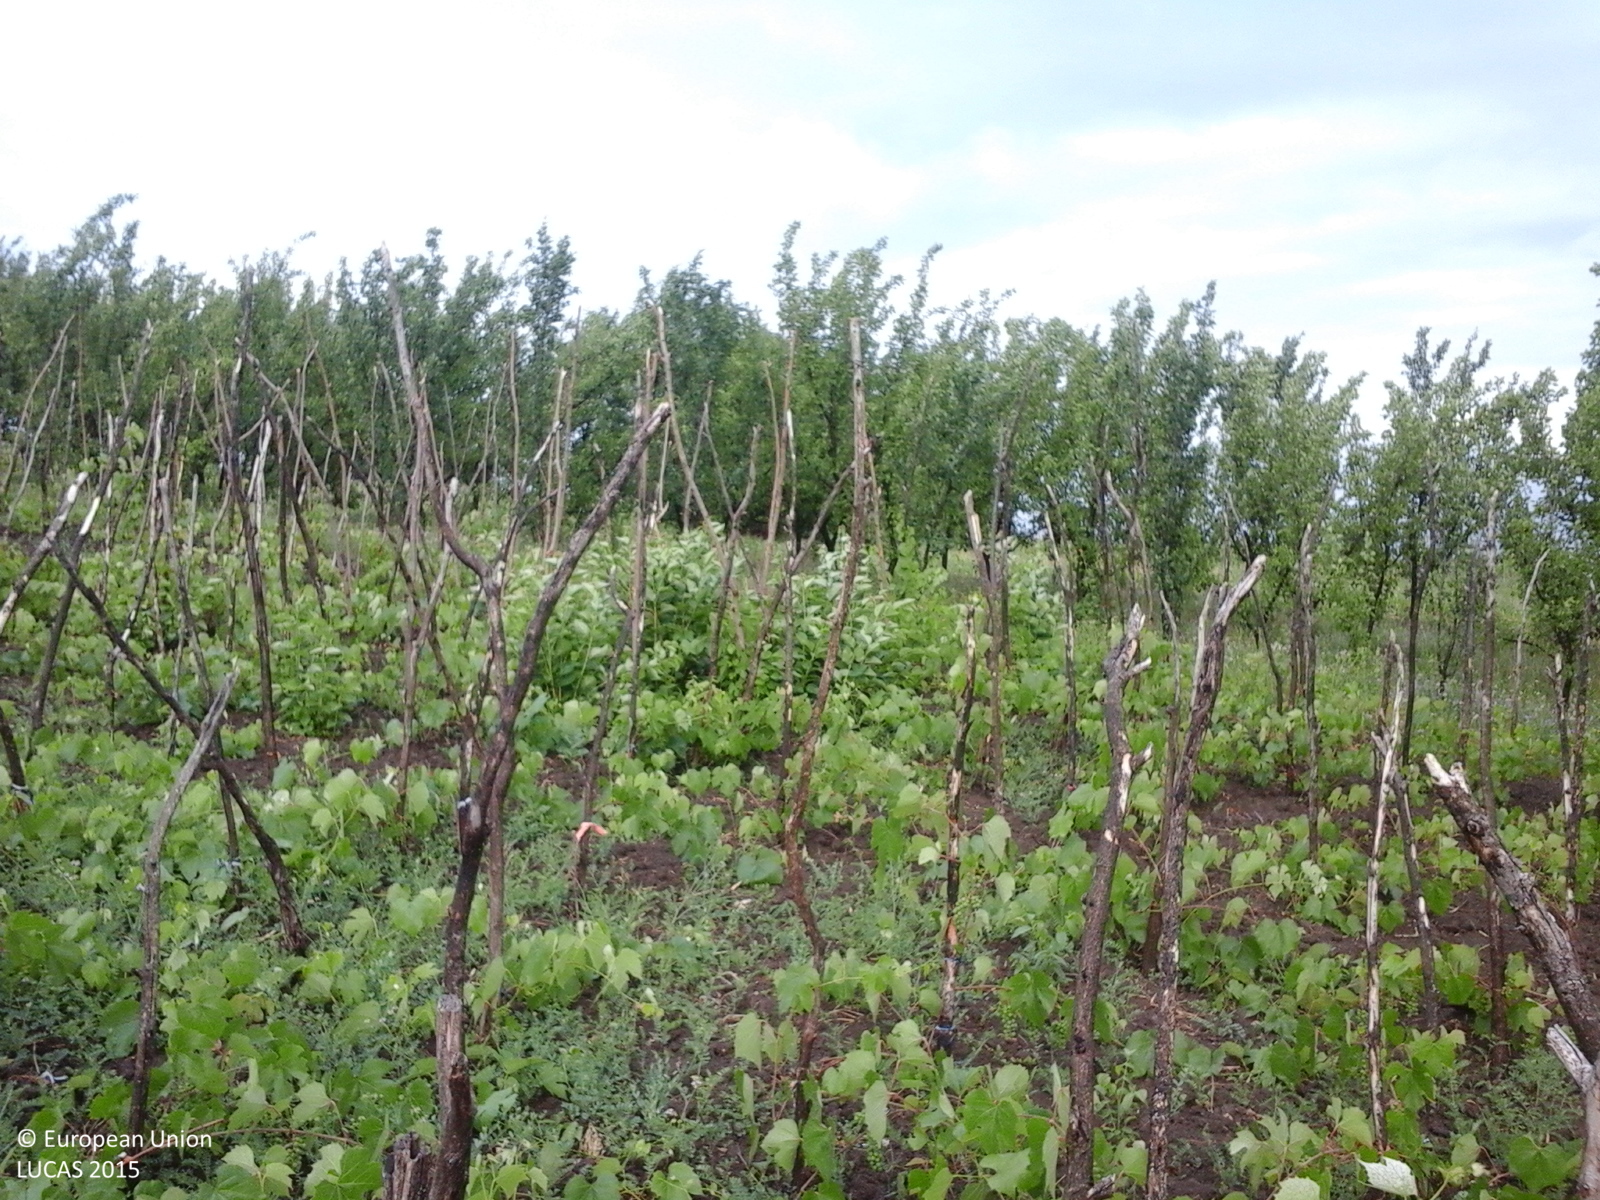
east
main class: Cropland
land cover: Vineyards
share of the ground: 50 - 75 %
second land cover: Other bare soil
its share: > 75 %
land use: Agriculture (excluding fallow land and kitchen gardens)
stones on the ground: < 10 %
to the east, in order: Vineyards; Other bare soil; Other fruit trees and berries; Maize; Grassland without tree/shrub cover; Vineyards; Lucerne; Maize; Vineyards; Single bushes/trees; Vineyards; Grassland without tree/shrub cover; Tracks; Common wheat
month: June
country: RO
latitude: 47.6404
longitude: 27.0226
